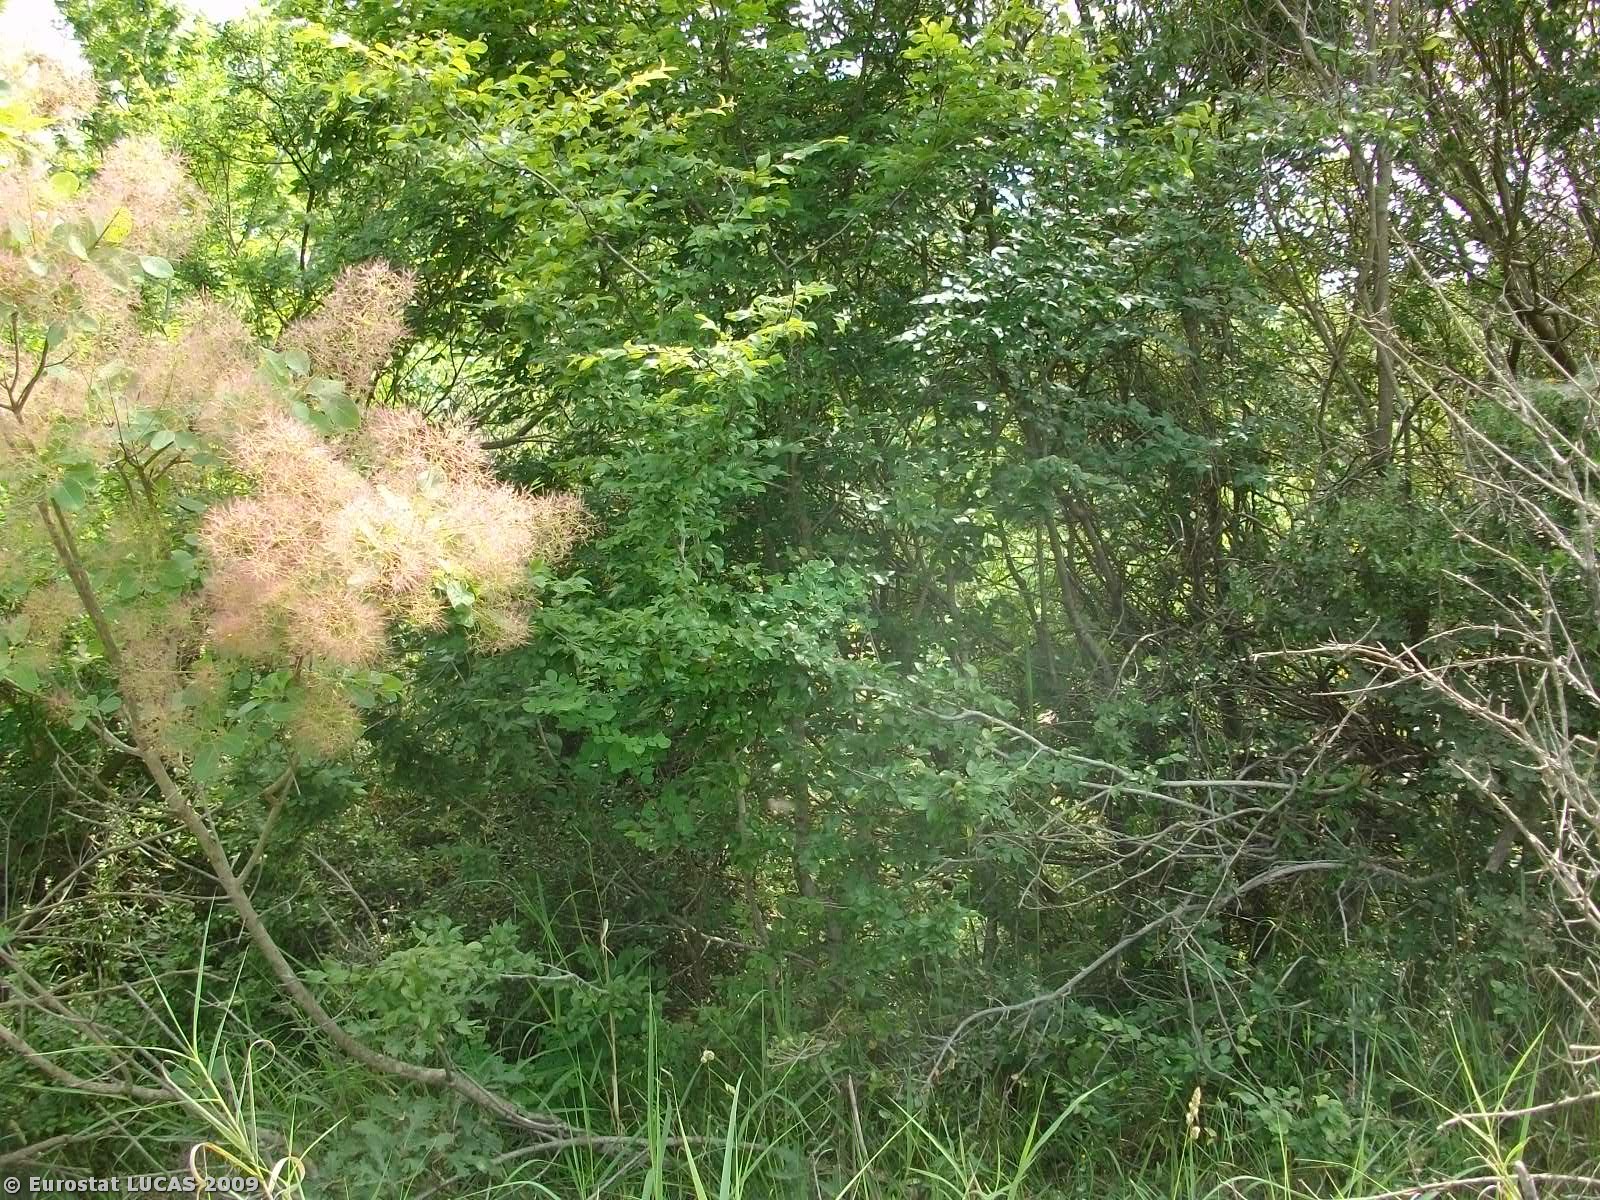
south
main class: Cropland
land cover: Olive groves
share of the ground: < 10 %
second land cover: Grassland with sparse tree/shrub cover
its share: > 75 %
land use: Agriculture (excluding fallow land and kitchen gardens)
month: June
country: GR
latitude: 39.6920
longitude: 22.8569
